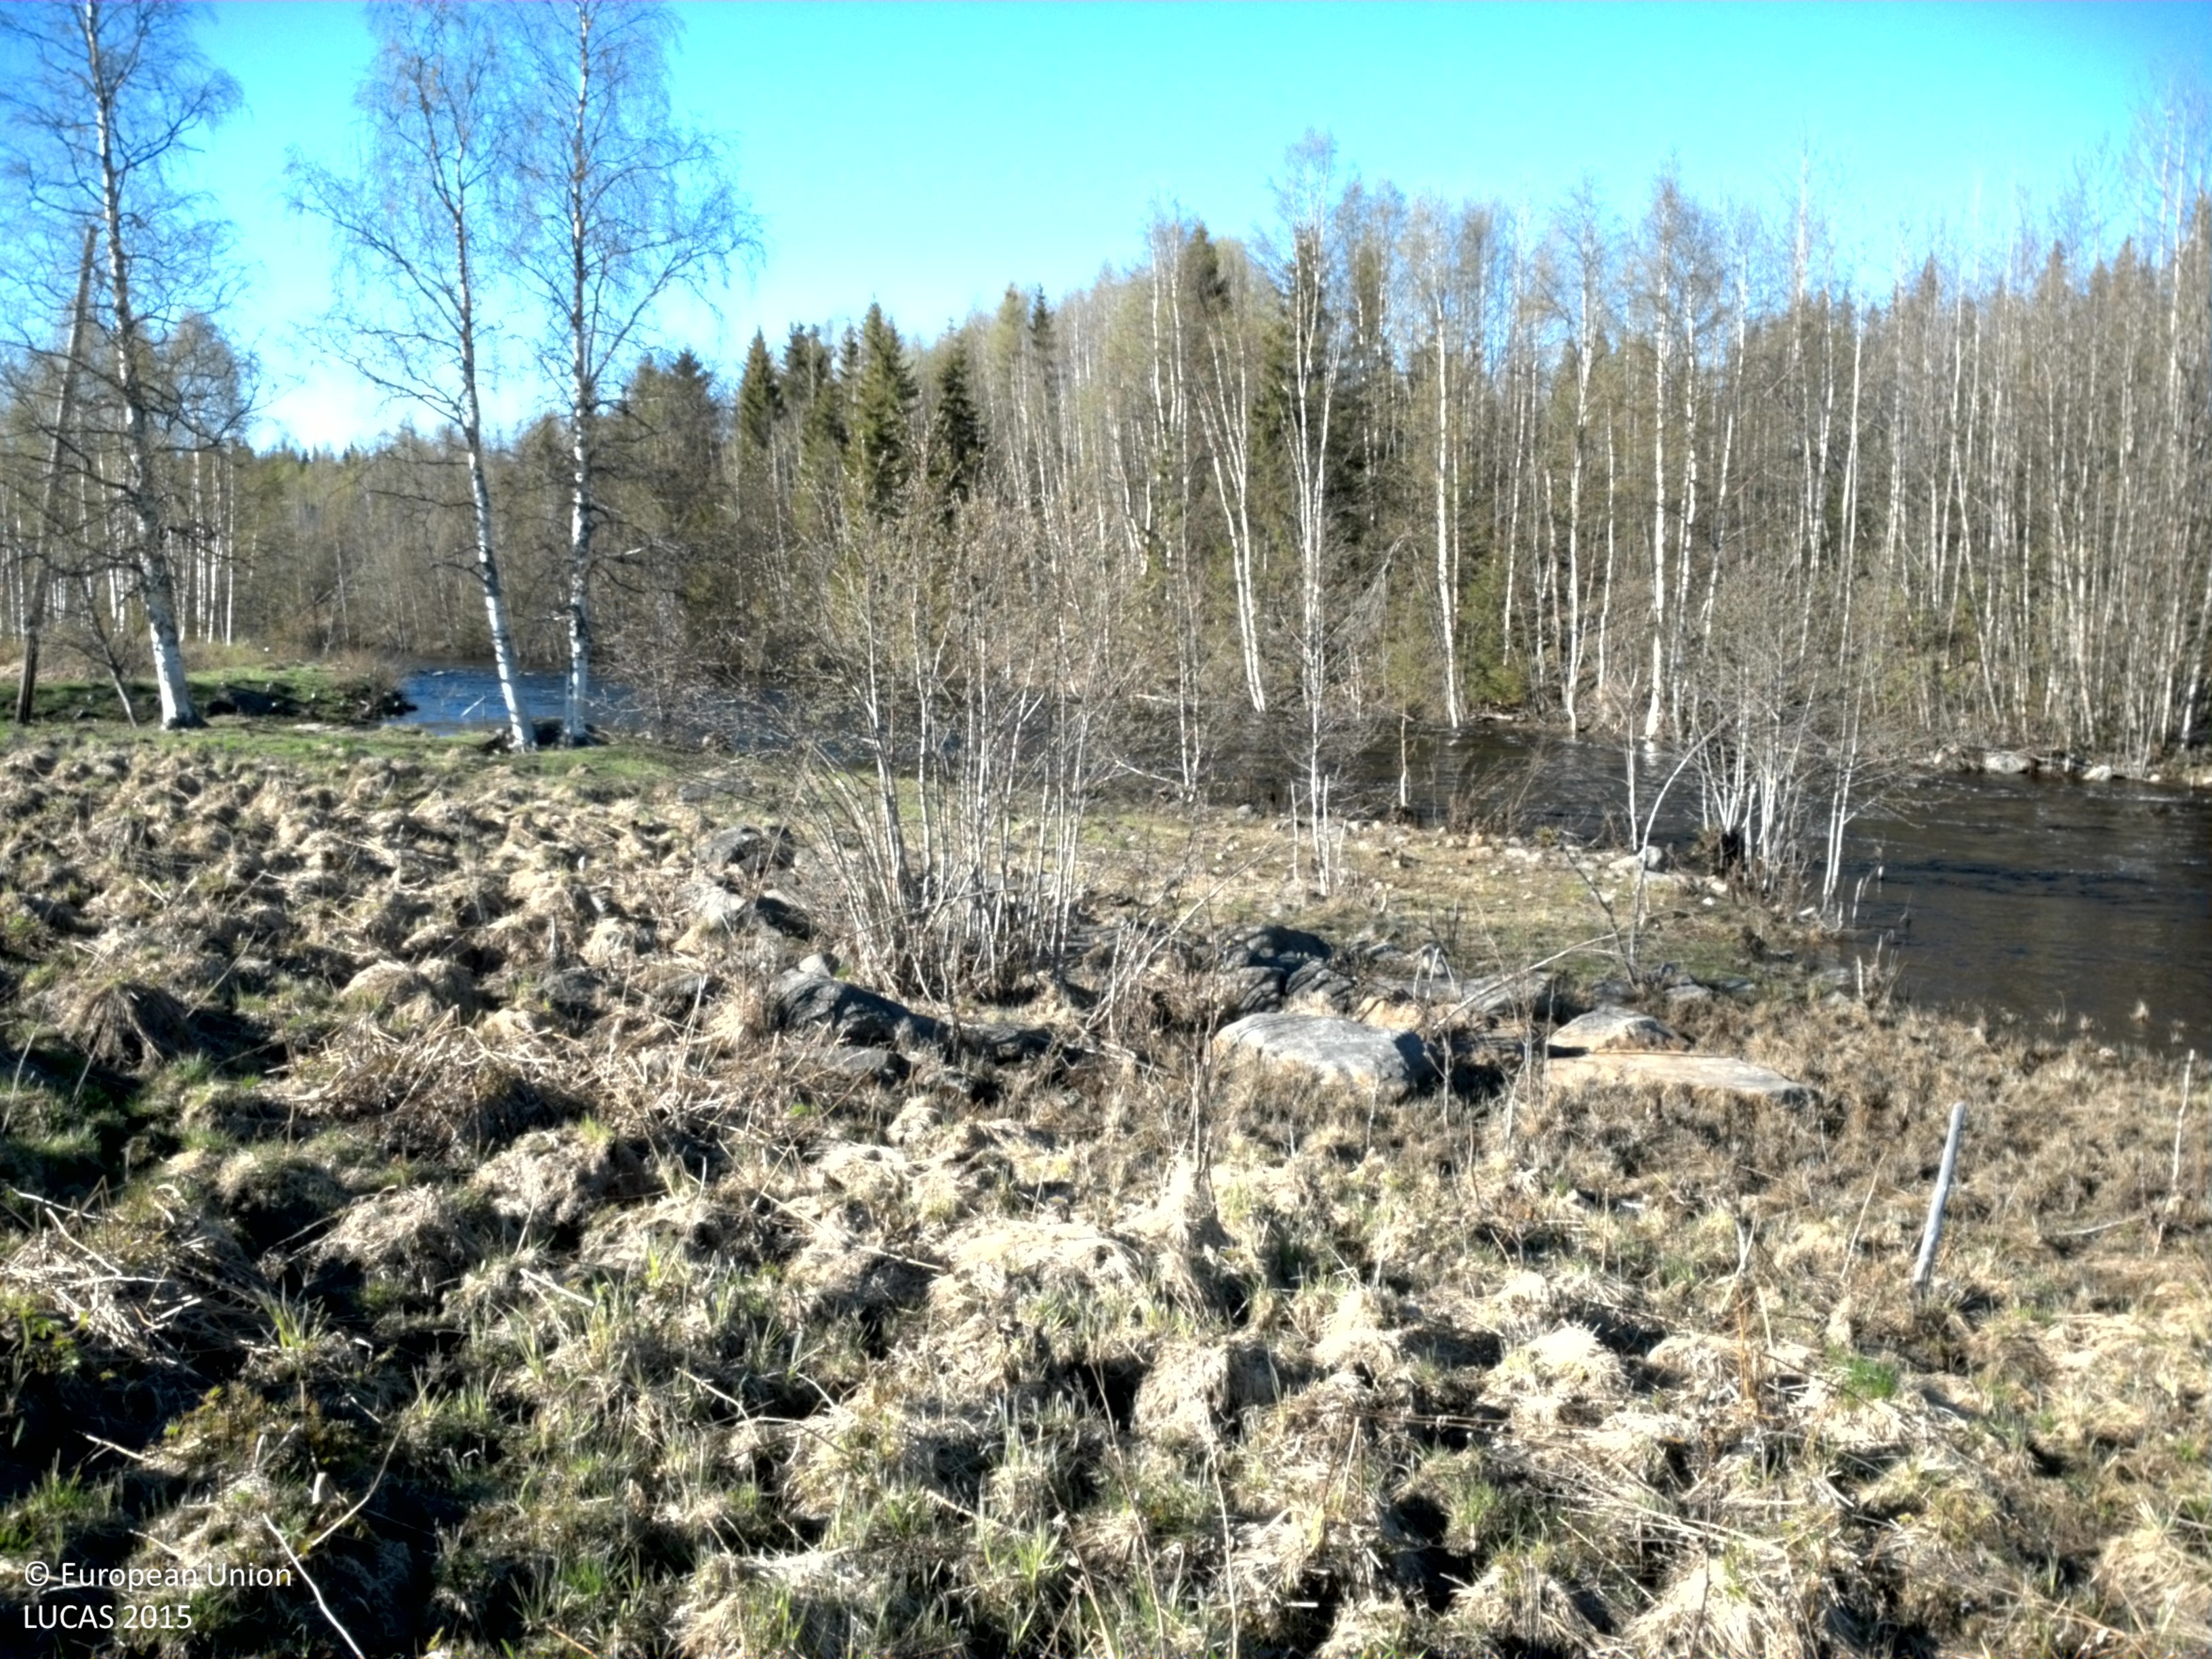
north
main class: Grassland
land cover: Grassland without tree/shrub cover
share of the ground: > 75 %
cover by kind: herbaceous plants 100 %
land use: Agriculture (excluding fallow land and kitchen gardens)
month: May
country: SE
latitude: 66.0918
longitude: 23.3661
